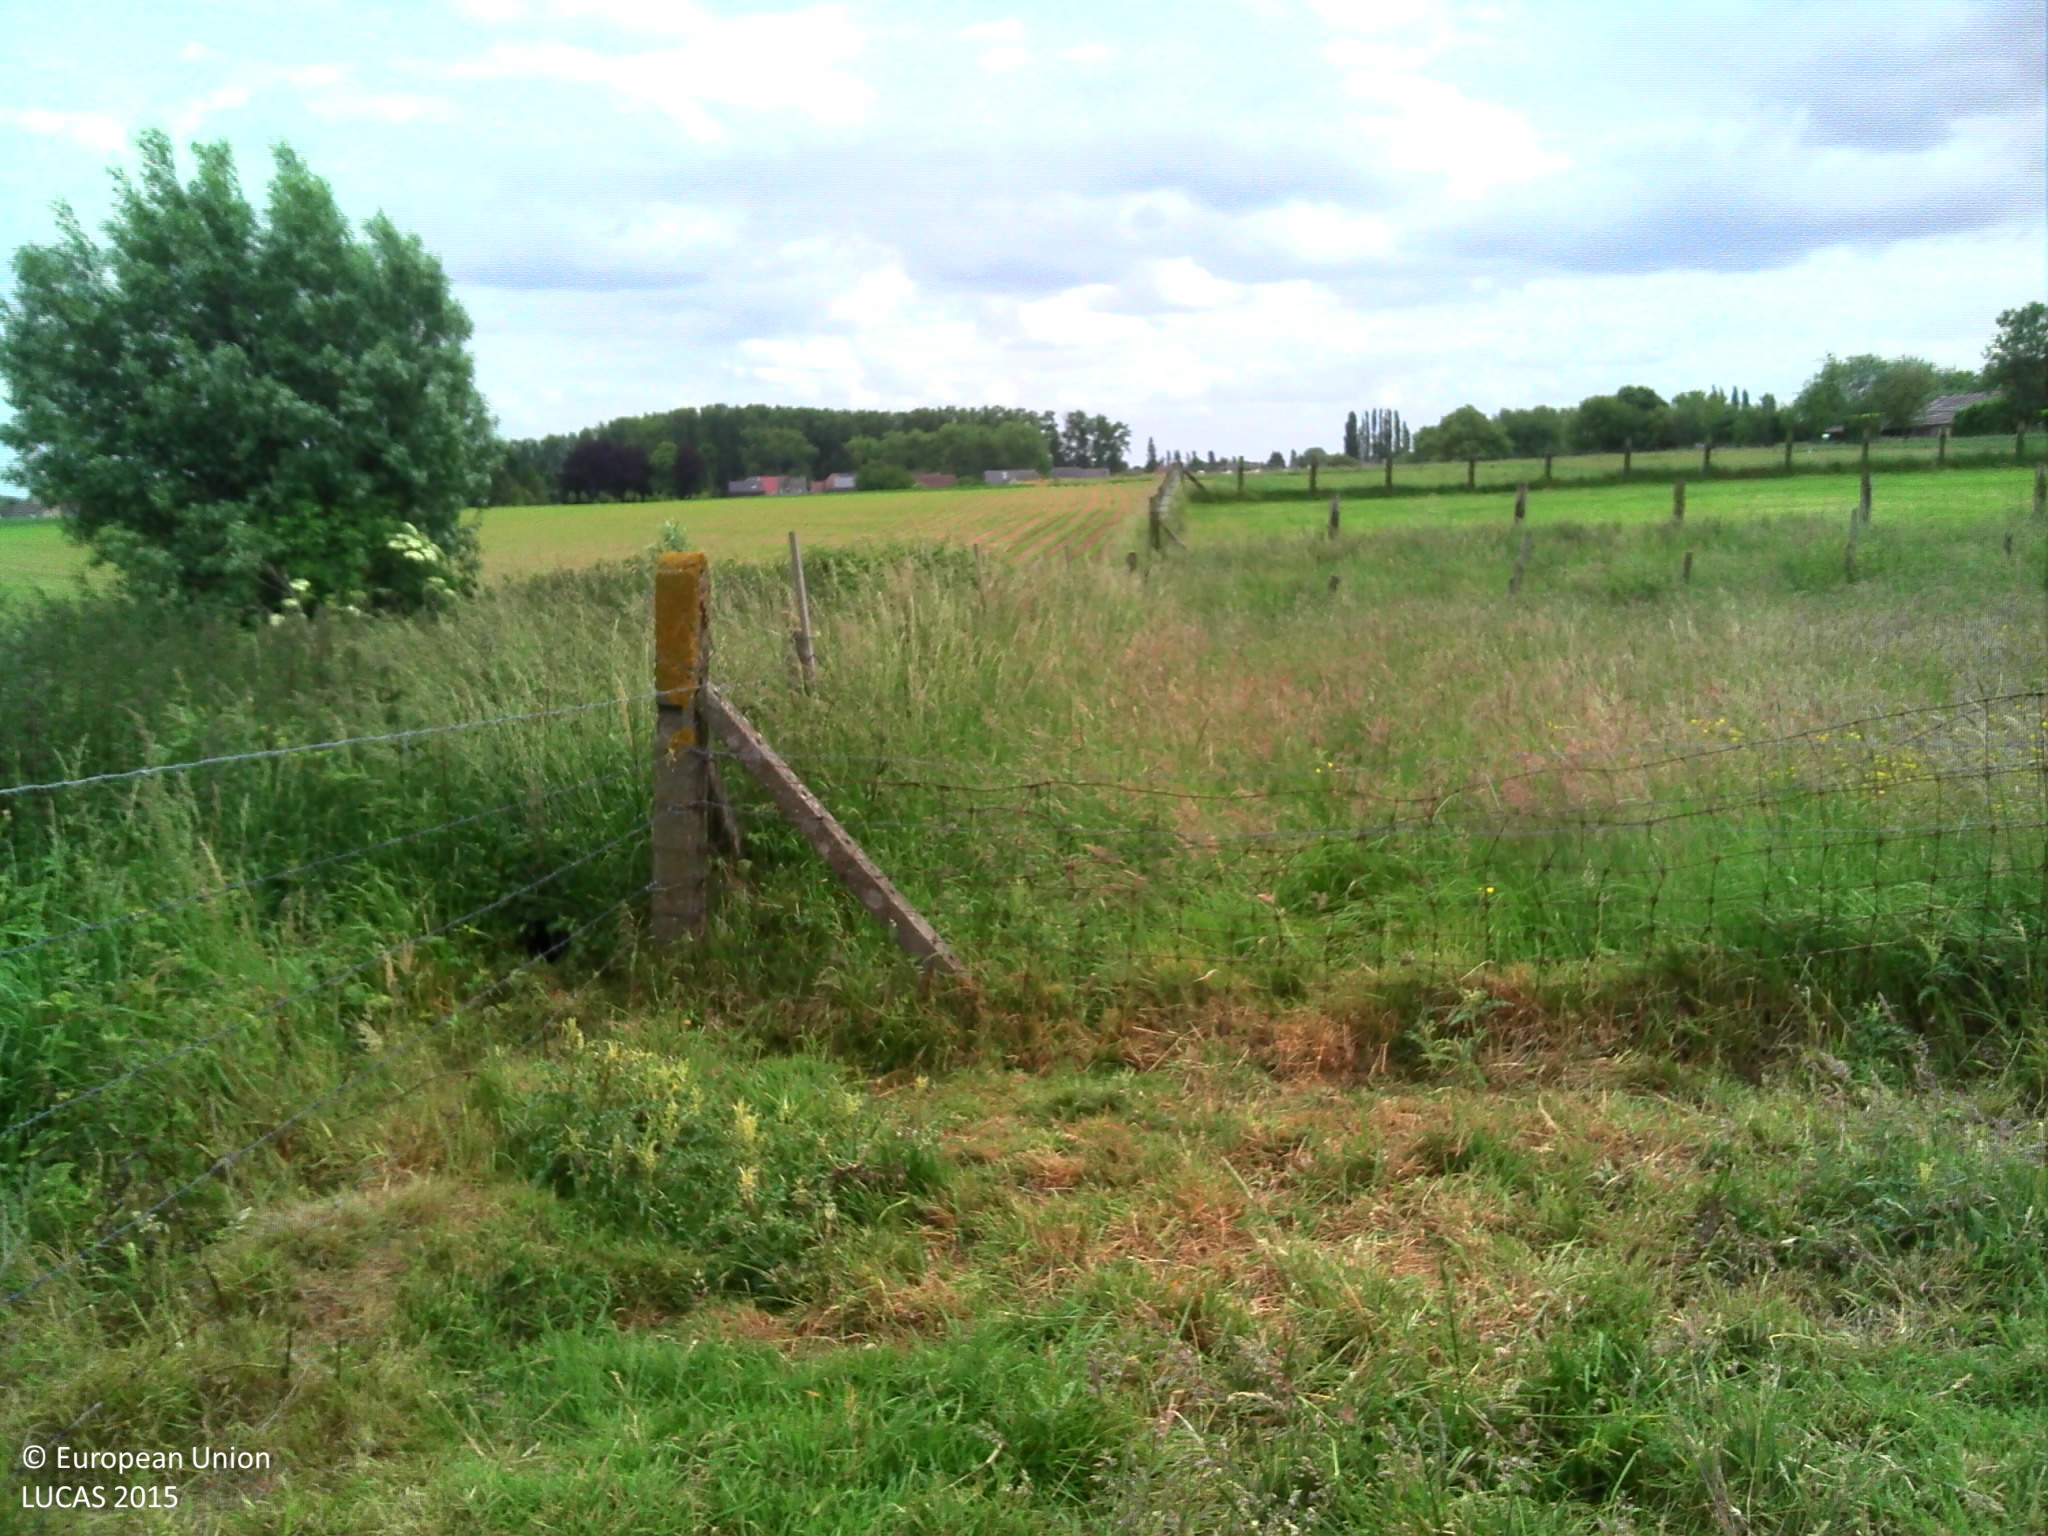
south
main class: Grassland
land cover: Grassland without tree/shrub cover
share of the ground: > 75 %
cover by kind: herbaceous plants 100 %
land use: Agriculture (excluding fallow land and kitchen gardens)
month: June
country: BE
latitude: 50.9101
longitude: 4.0066
